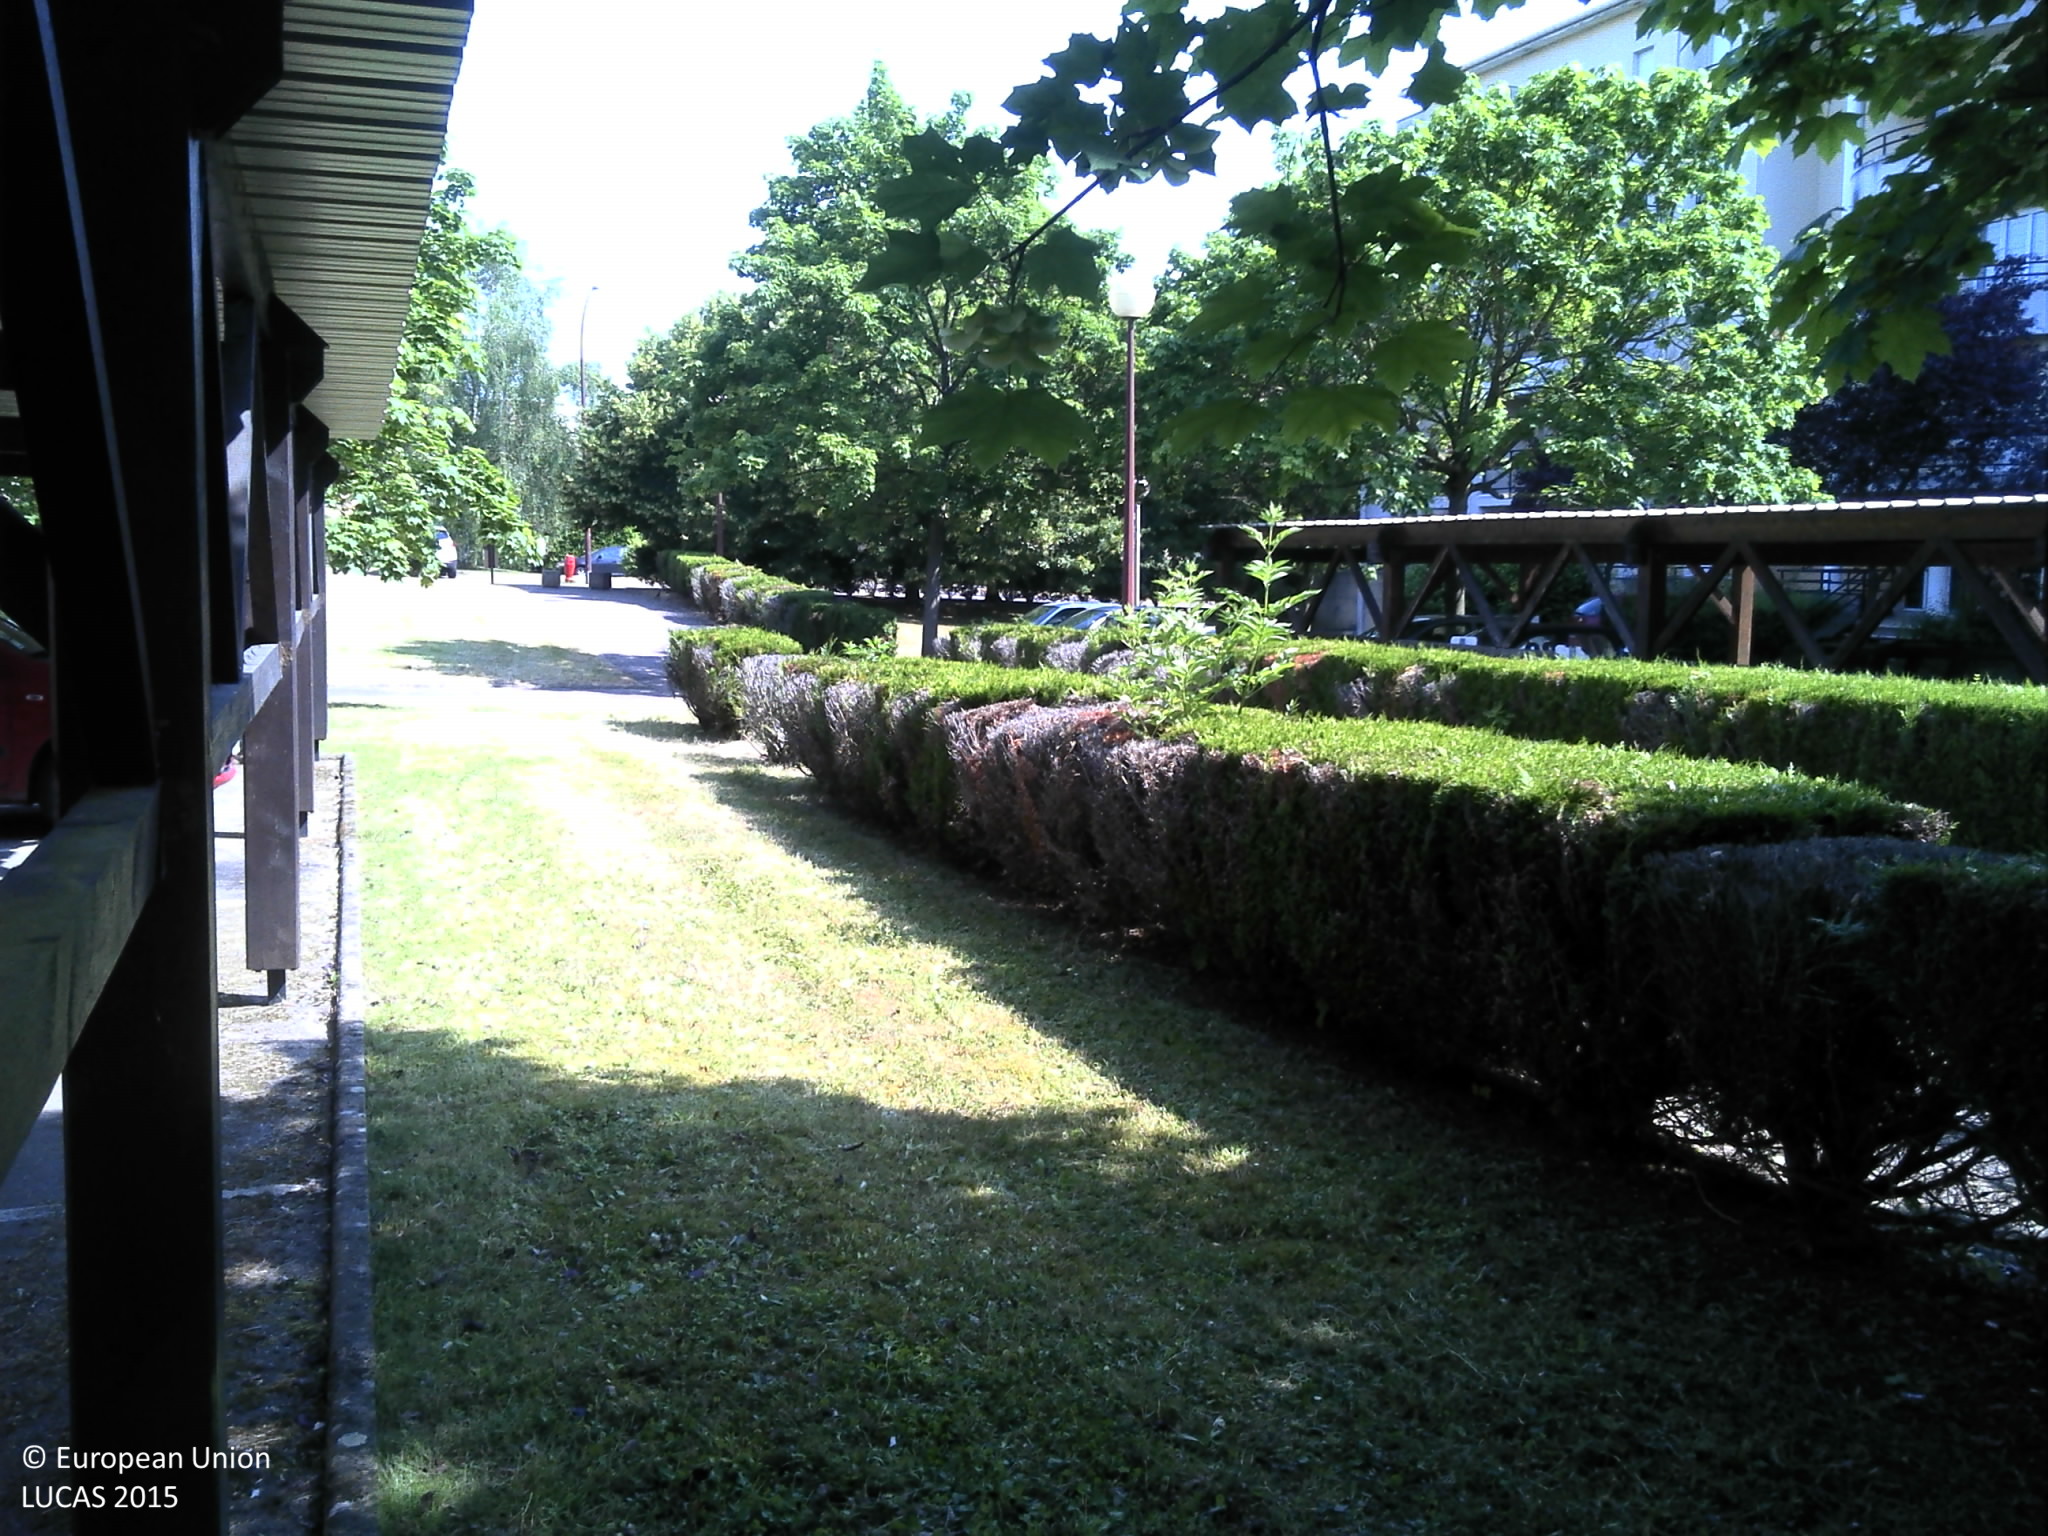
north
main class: Woodland
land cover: Broadleaved woodland
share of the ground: 25 - 50 %
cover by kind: herbaceous plants 60 %, broadleaved forest trees 40 %
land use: Residential
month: June
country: FR
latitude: 49.0939
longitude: 6.1789
